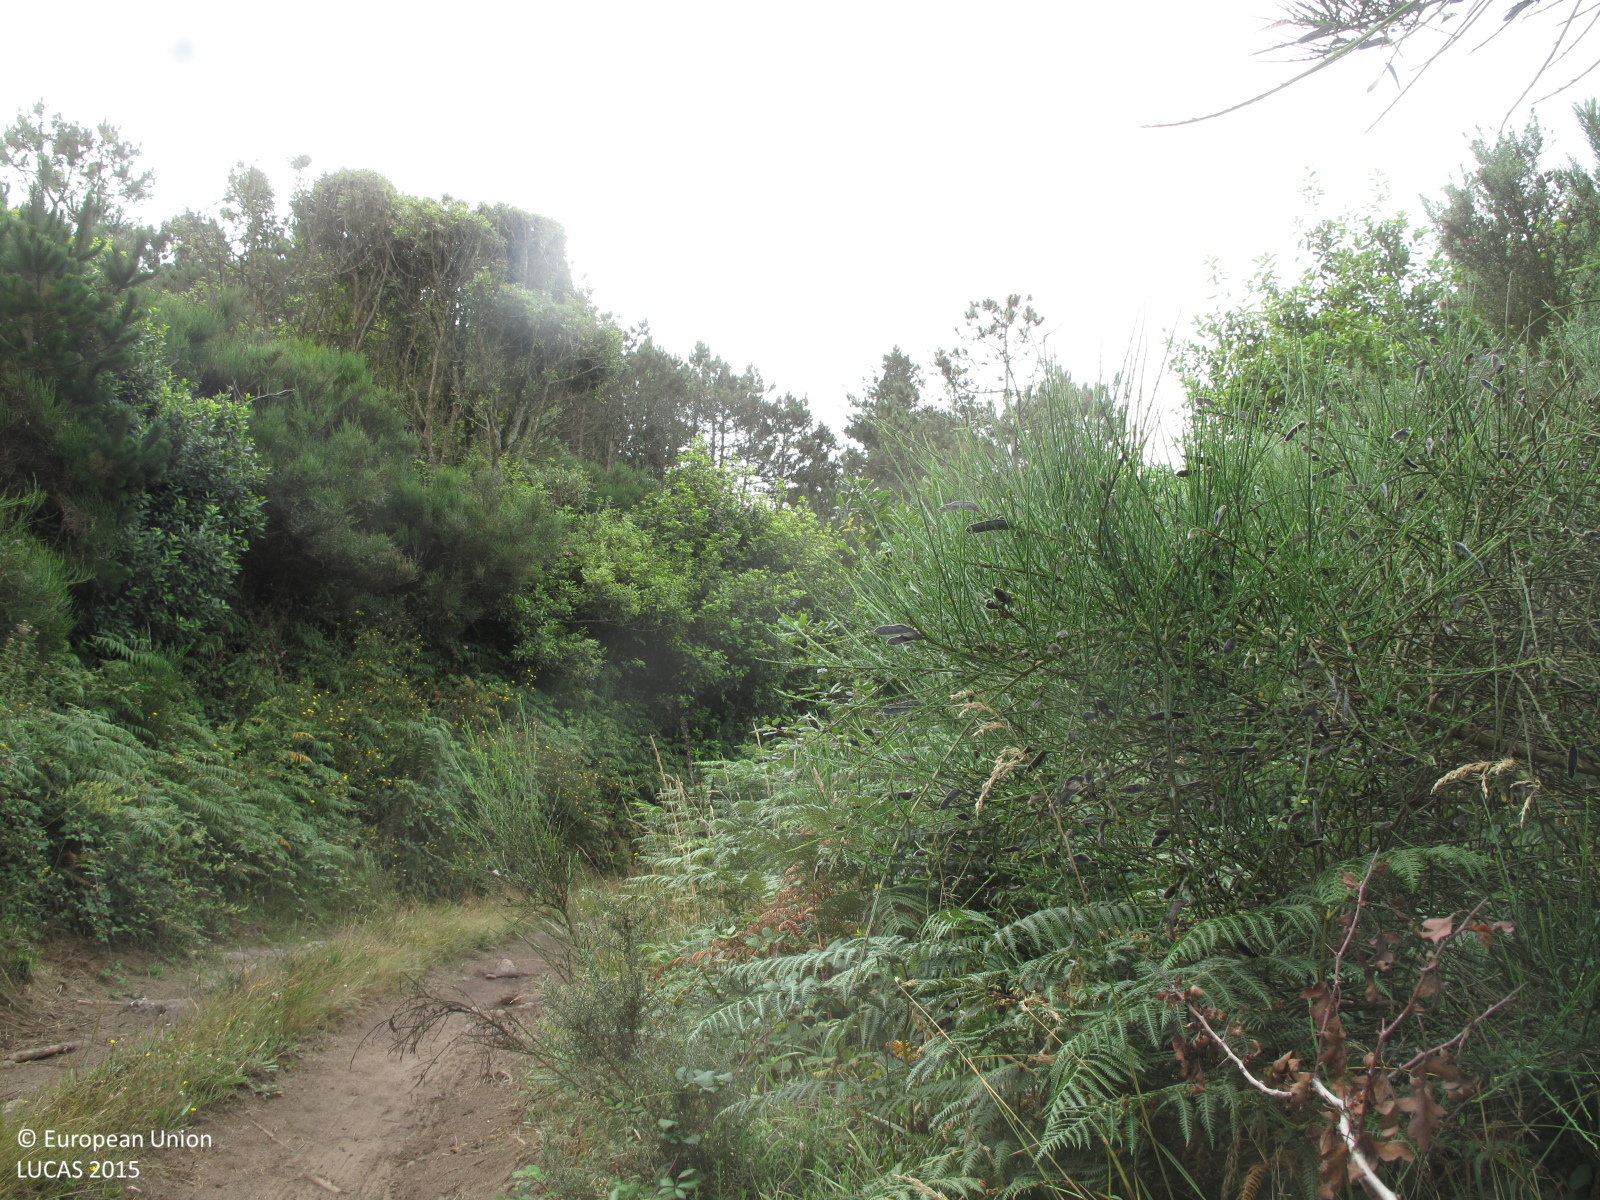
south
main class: Woodland
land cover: Broadleaved woodland
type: exotic forest
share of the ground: 25 - 50 %
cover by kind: herbaceous plants 40 %, broadleaved forest trees 35 %, shrubs 20 %, coniferous forest trees 5 %
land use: Forestry
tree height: < 5 m
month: July
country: ES
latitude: 43.0856
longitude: -9.2315
